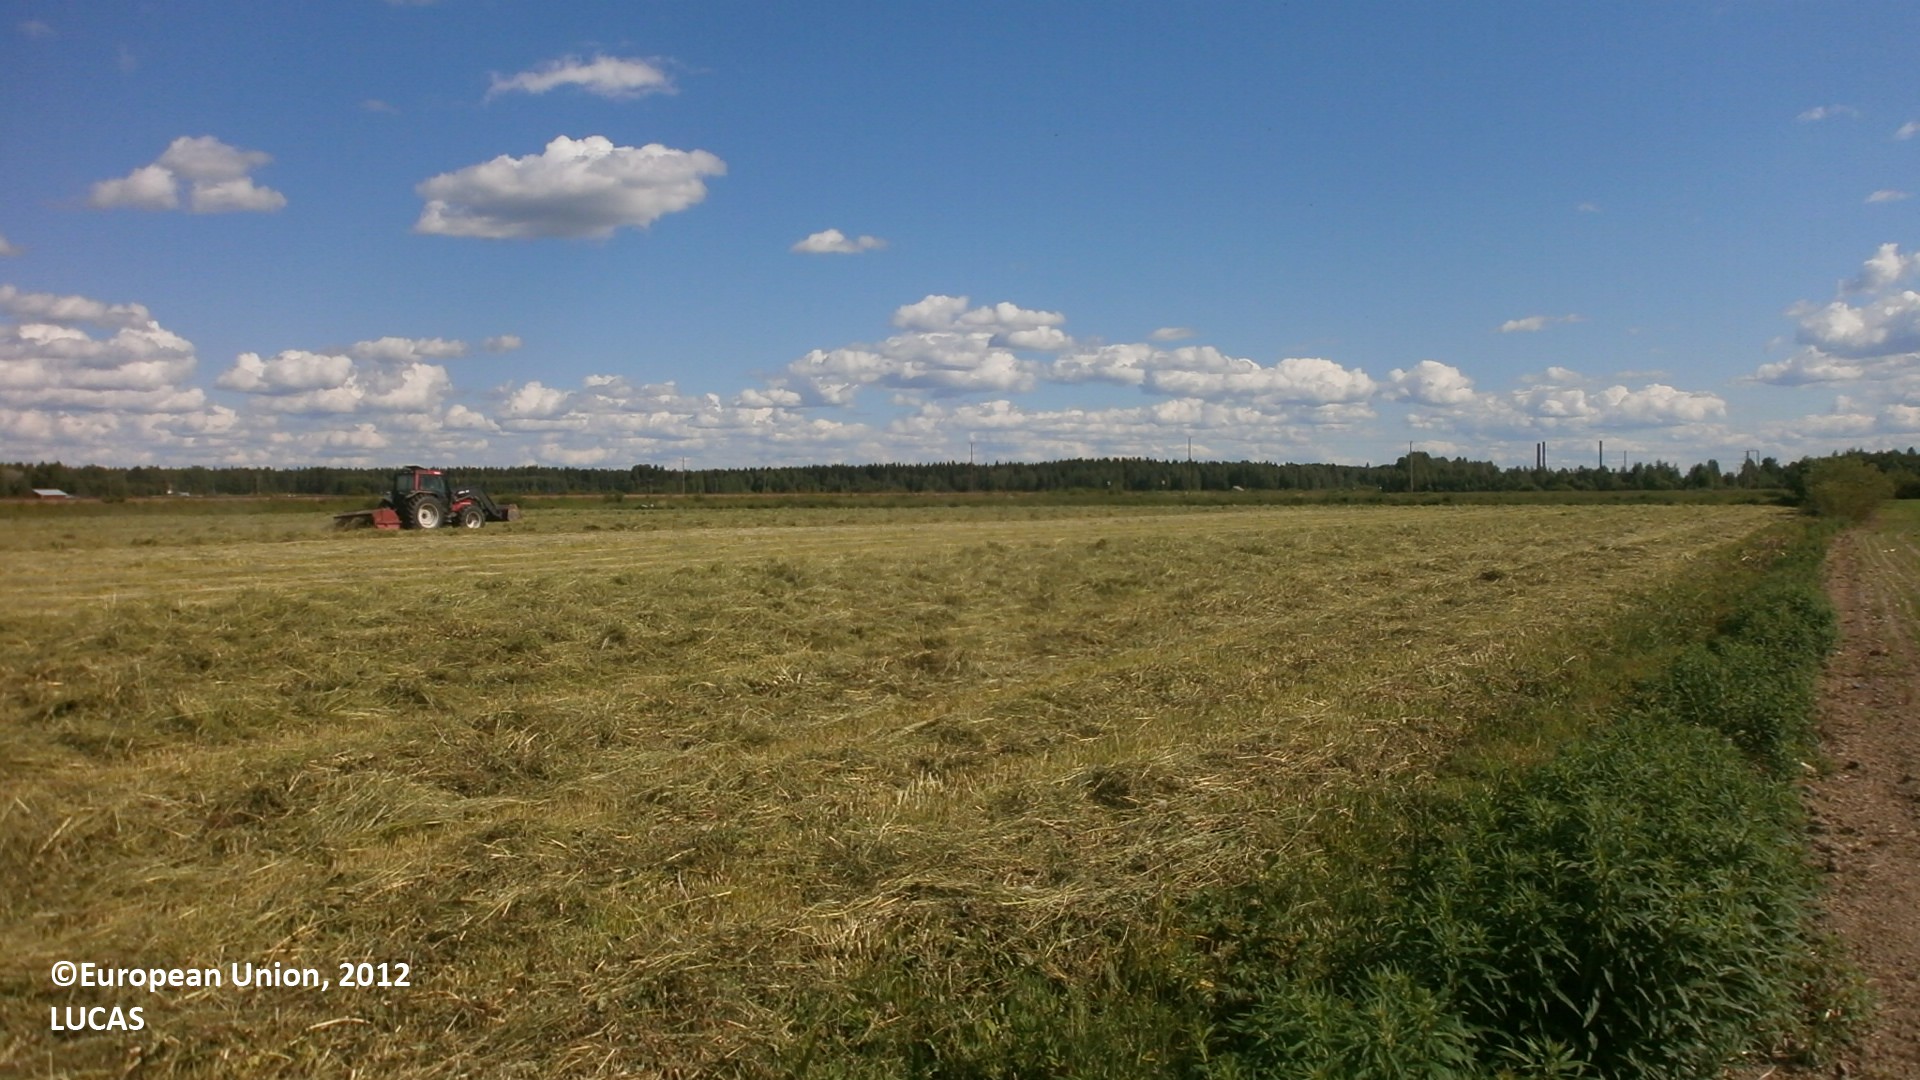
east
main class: Cropland
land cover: Oats
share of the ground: 10 - 25 %
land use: Agriculture (excluding fallow land and kitchen gardens)
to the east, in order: Oats; Shruby margins; Ditches and canals; Temporary grasslands; Shruby margins; Ditches and canals; Shruby margins; Temporary grasslands; Shruby margins; Ditches and canals; Shruby margins; Temporary grasslands; Shruby margins; Ditches and canals; Spontaneously vegetated surfaces
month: July
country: FI
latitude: 64.0173
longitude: 24.7481
